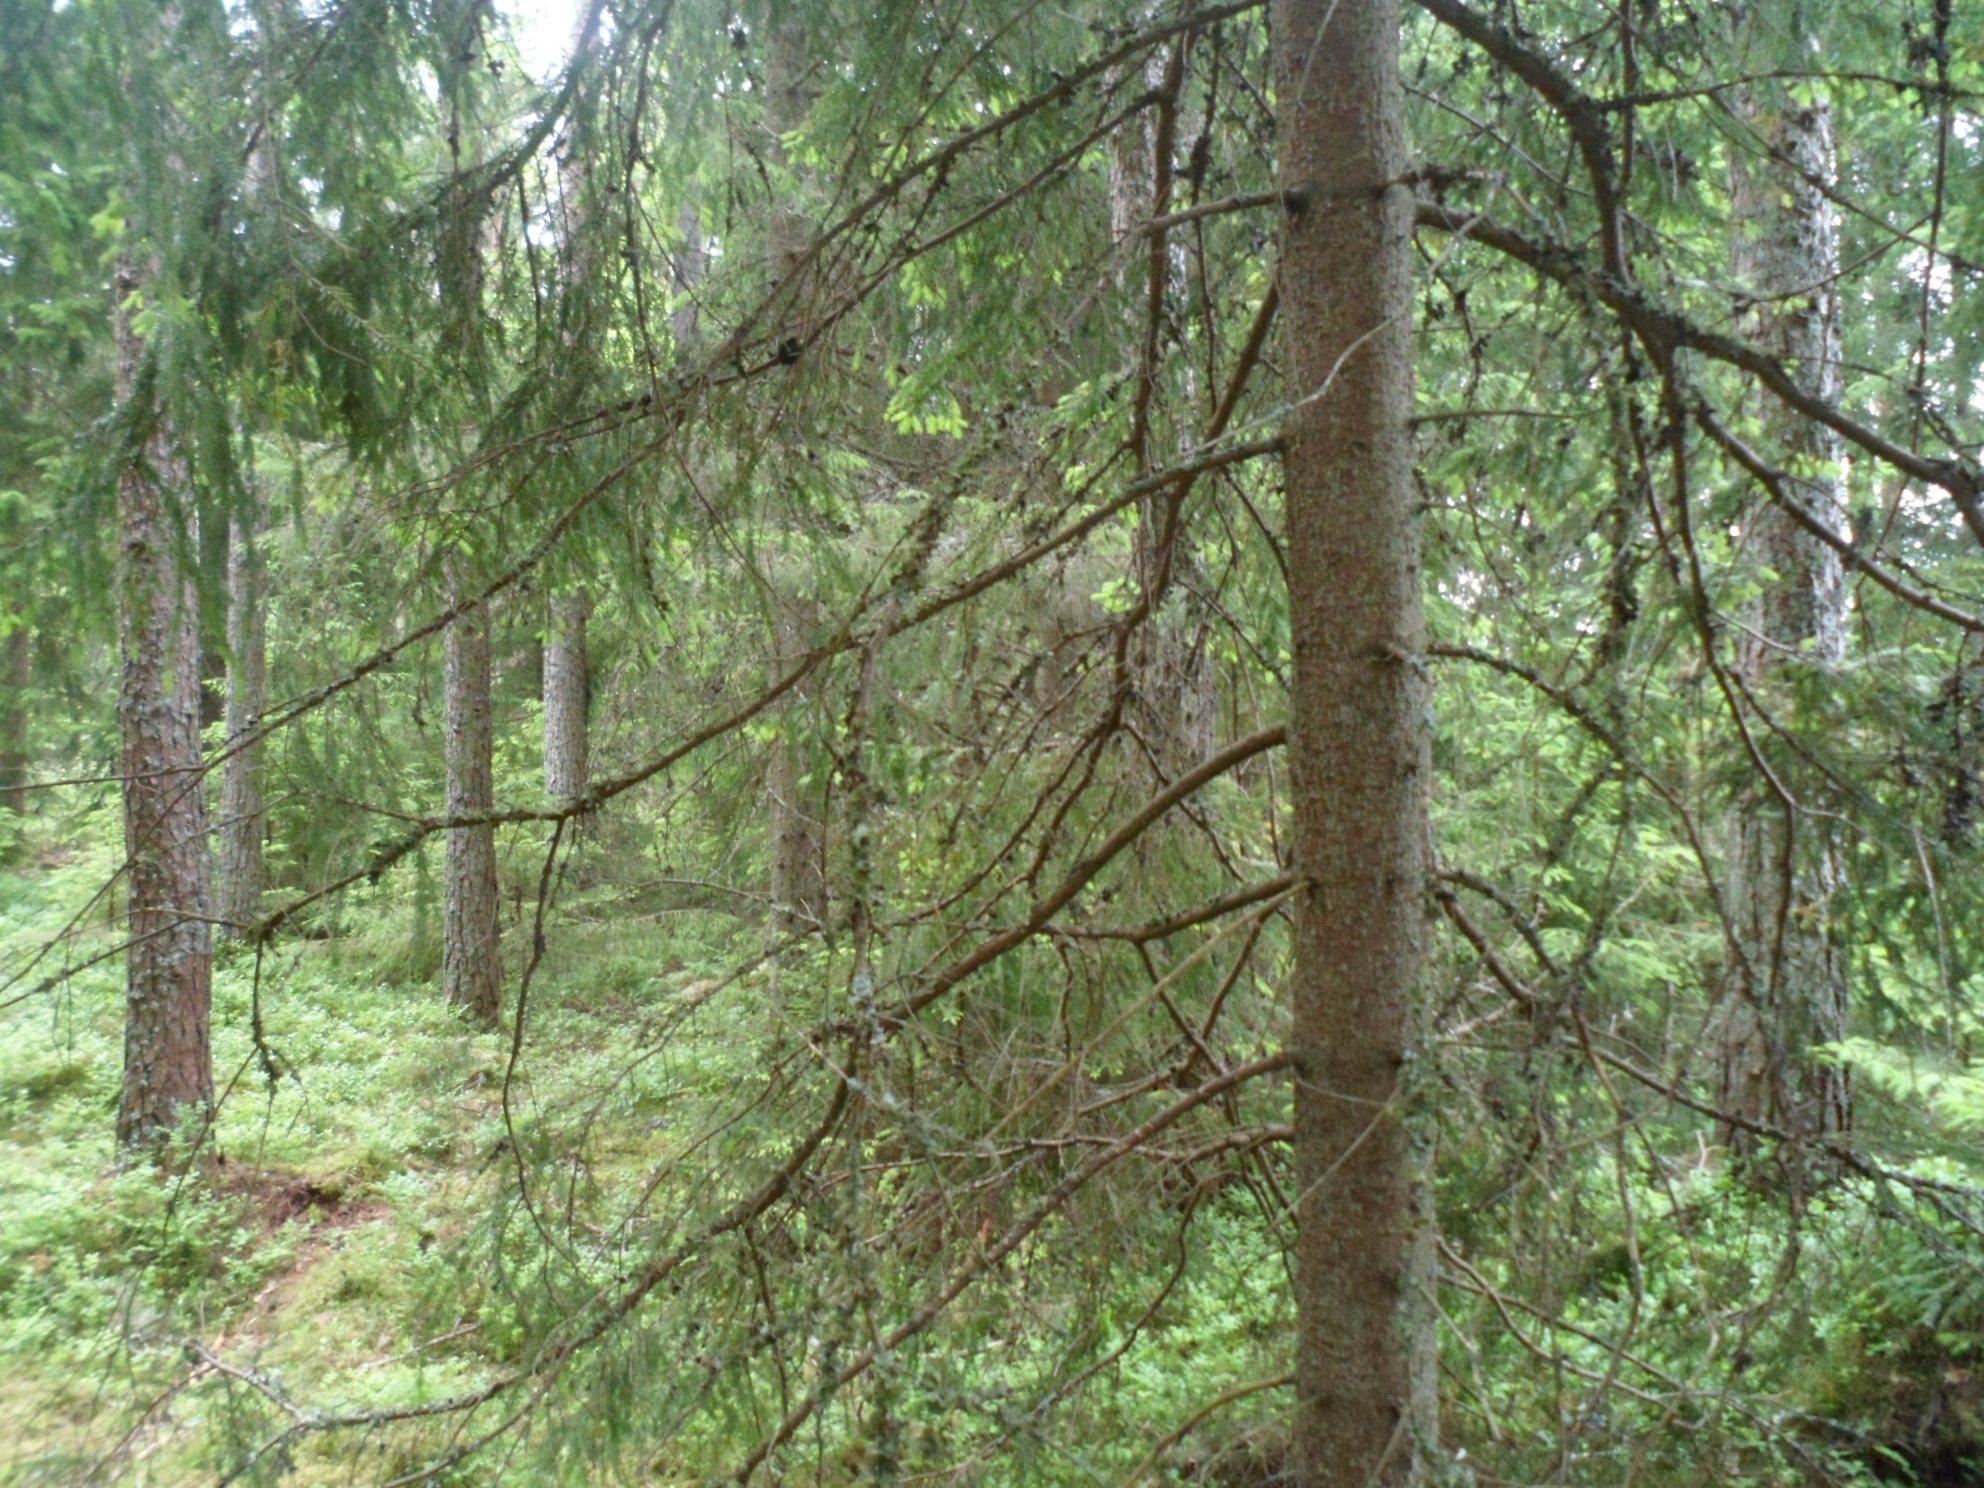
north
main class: Woodland
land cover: Spruce dominated coniferous woodland
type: boreal forest
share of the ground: 50 - 75 %
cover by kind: coniferous forest trees 60 %, shrubs 15 %, herbaceous plants 15 %, lichens and mosses 10 %
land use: Forestry
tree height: > 5 m
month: June
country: SE
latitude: 57.0231
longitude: 15.5494
